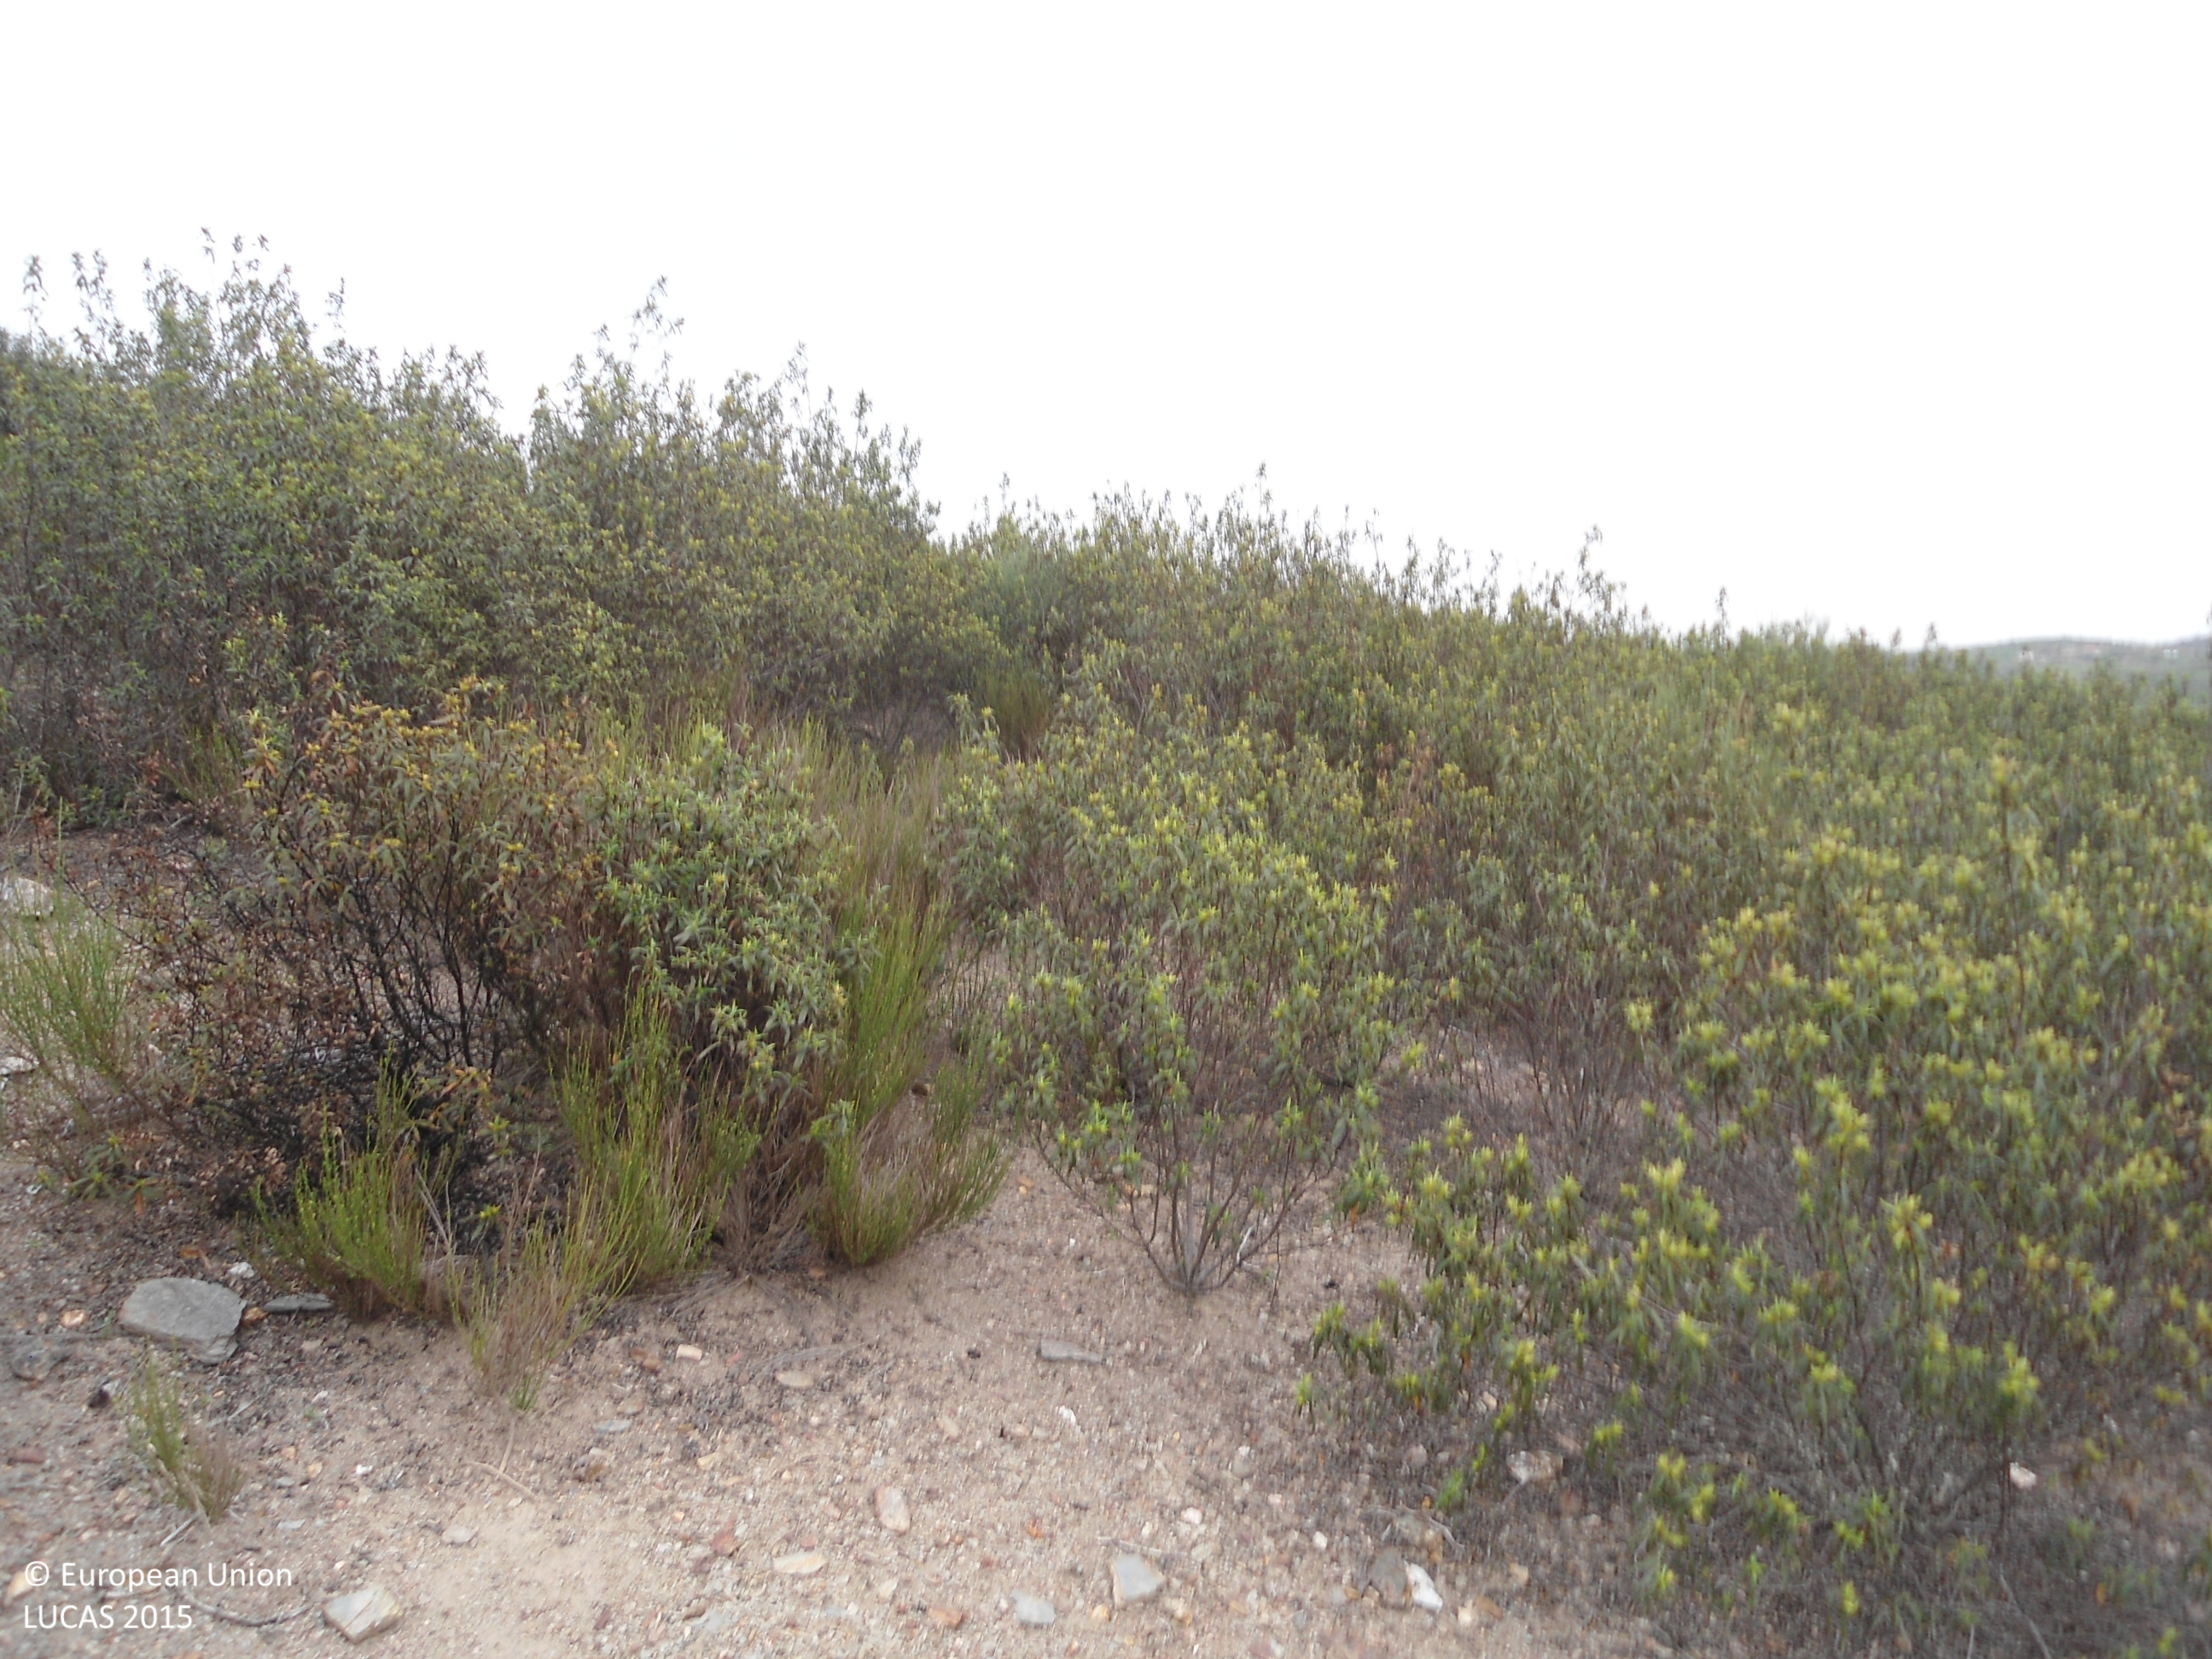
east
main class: Shrubland
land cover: Shrubland without tree cover
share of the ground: > 75 %
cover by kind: shrubs 95 %, consolidated bare surface 5 %
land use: Semi-natural and natural areas not in use
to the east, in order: Shrubland without tree cover; Grassland without tree/shrub cover; Shrubland without tree cover; Grassland with sparse tree/shrub cover
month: April
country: ES
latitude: 41.7893
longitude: -6.4836
